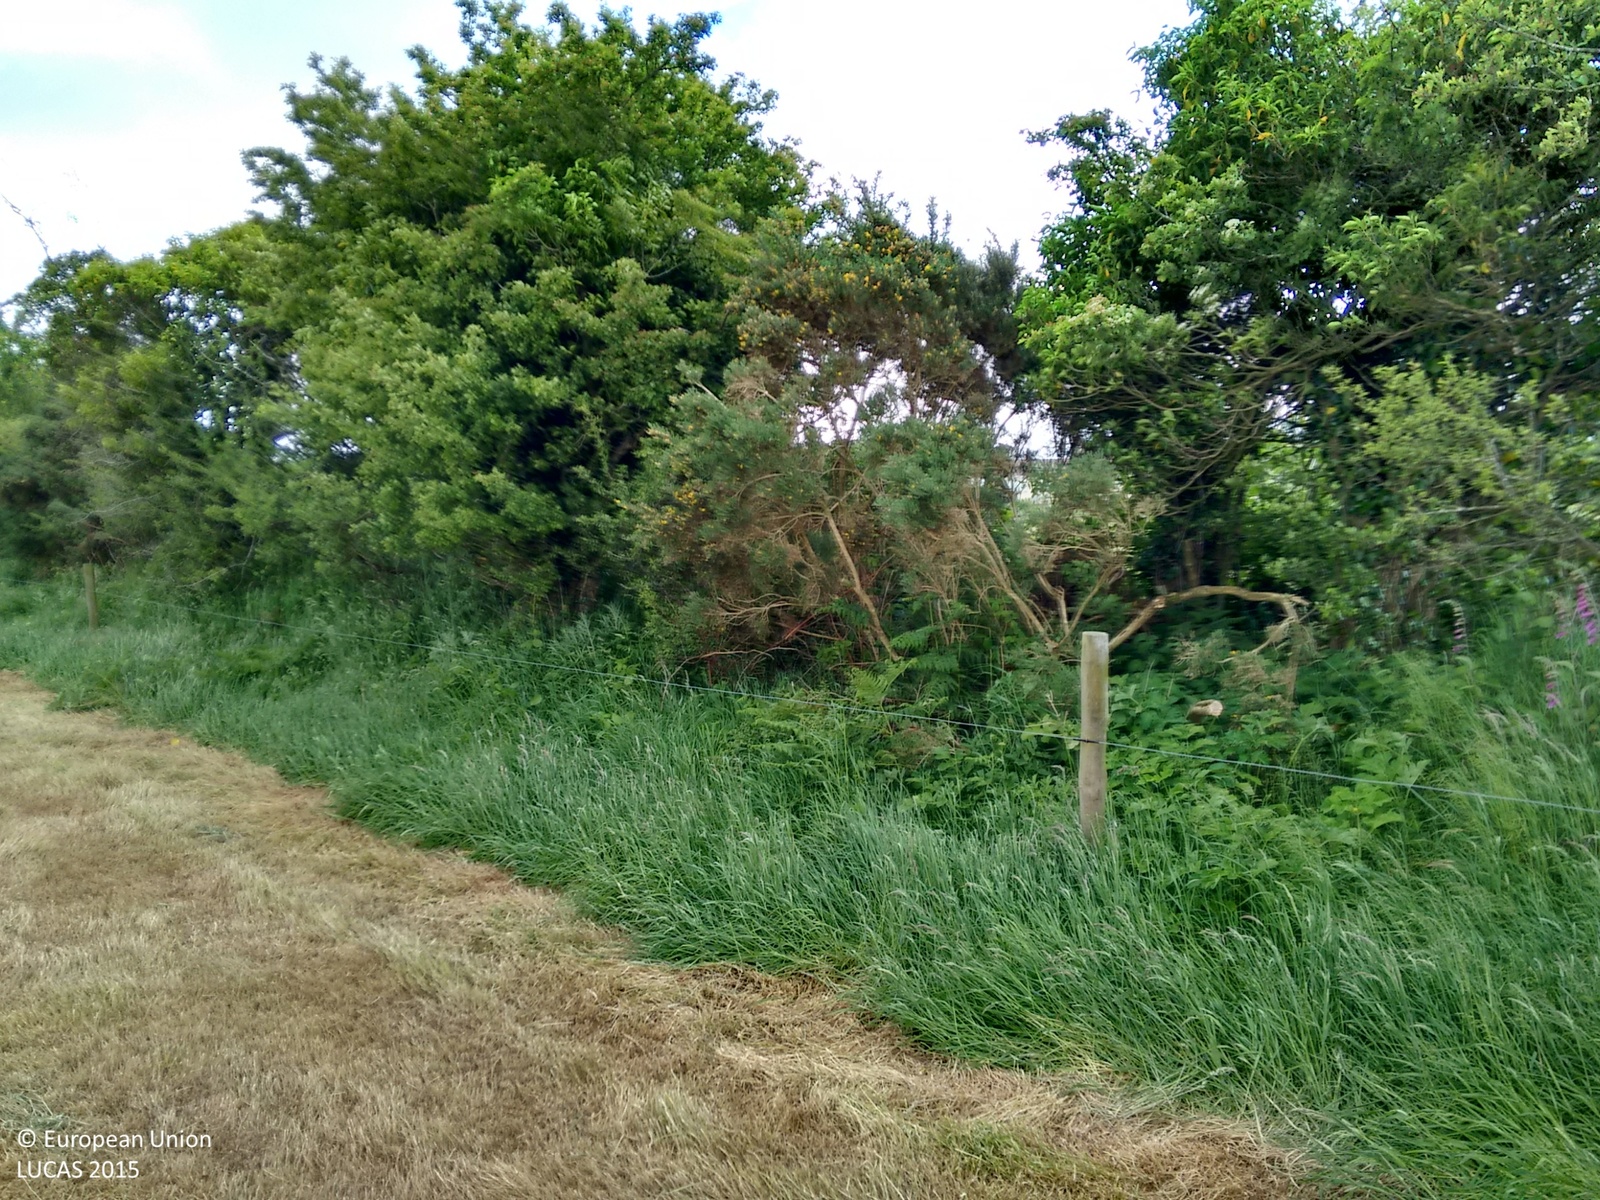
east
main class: Grassland
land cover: Grassland without tree/shrub cover
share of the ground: > 75 %
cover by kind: herbaceous plants 100 %
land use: Agriculture (excluding fallow land and kitchen gardens)
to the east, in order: Grassland without tree/shrub cover; Fences; Abandoned hedges; Ditches and canals; Fences; Grassland without tree/shrub cover; Artificial constructions in urban areas; Grass margins; Dry stone walls; Shrubland without tree cover; Electric lines; Shrubland without tree cover; Fences; Grassland without tree/shrub cover
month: June
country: IE
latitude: 52.2088
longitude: -7.3493
